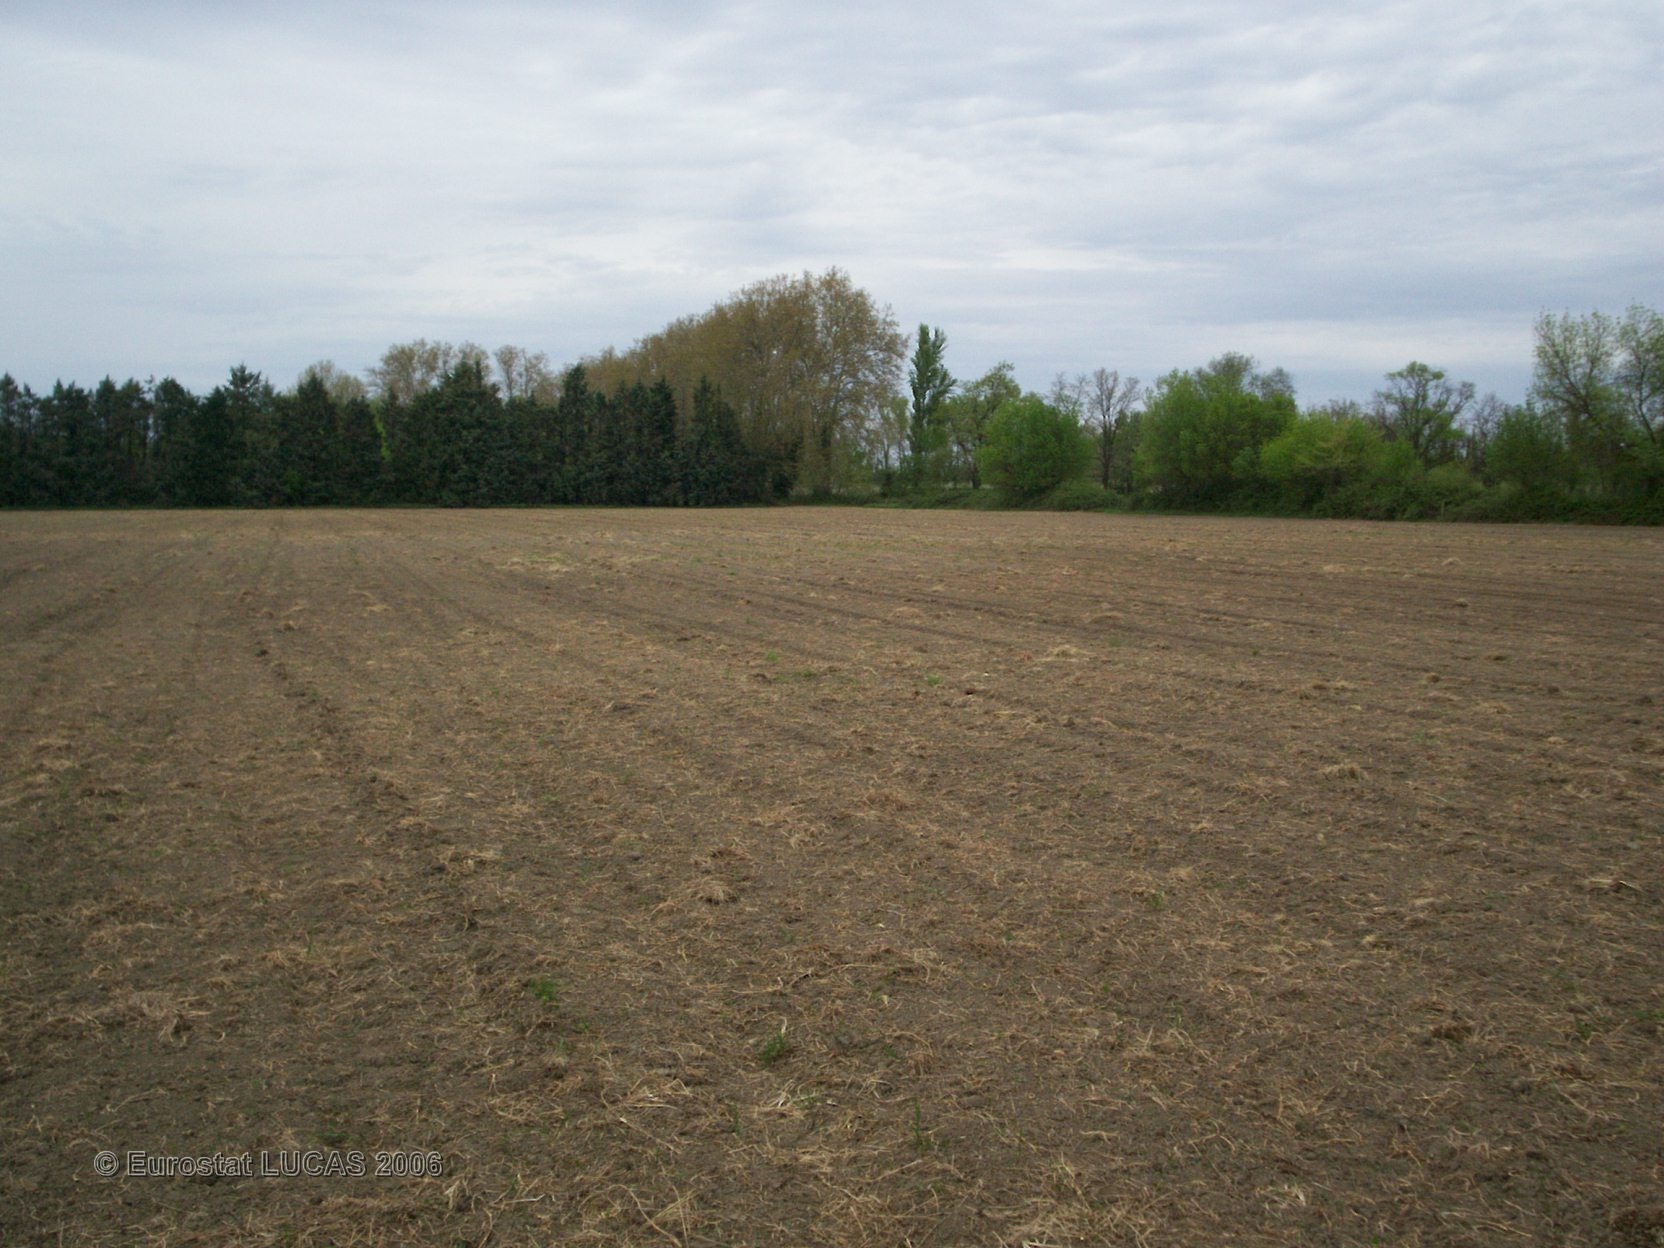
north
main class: Cropland
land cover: Lucerne
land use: Agriculture (excluding fallow land and kitchen gardens)
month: June
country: FR
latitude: 43.8455
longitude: 4.8966
